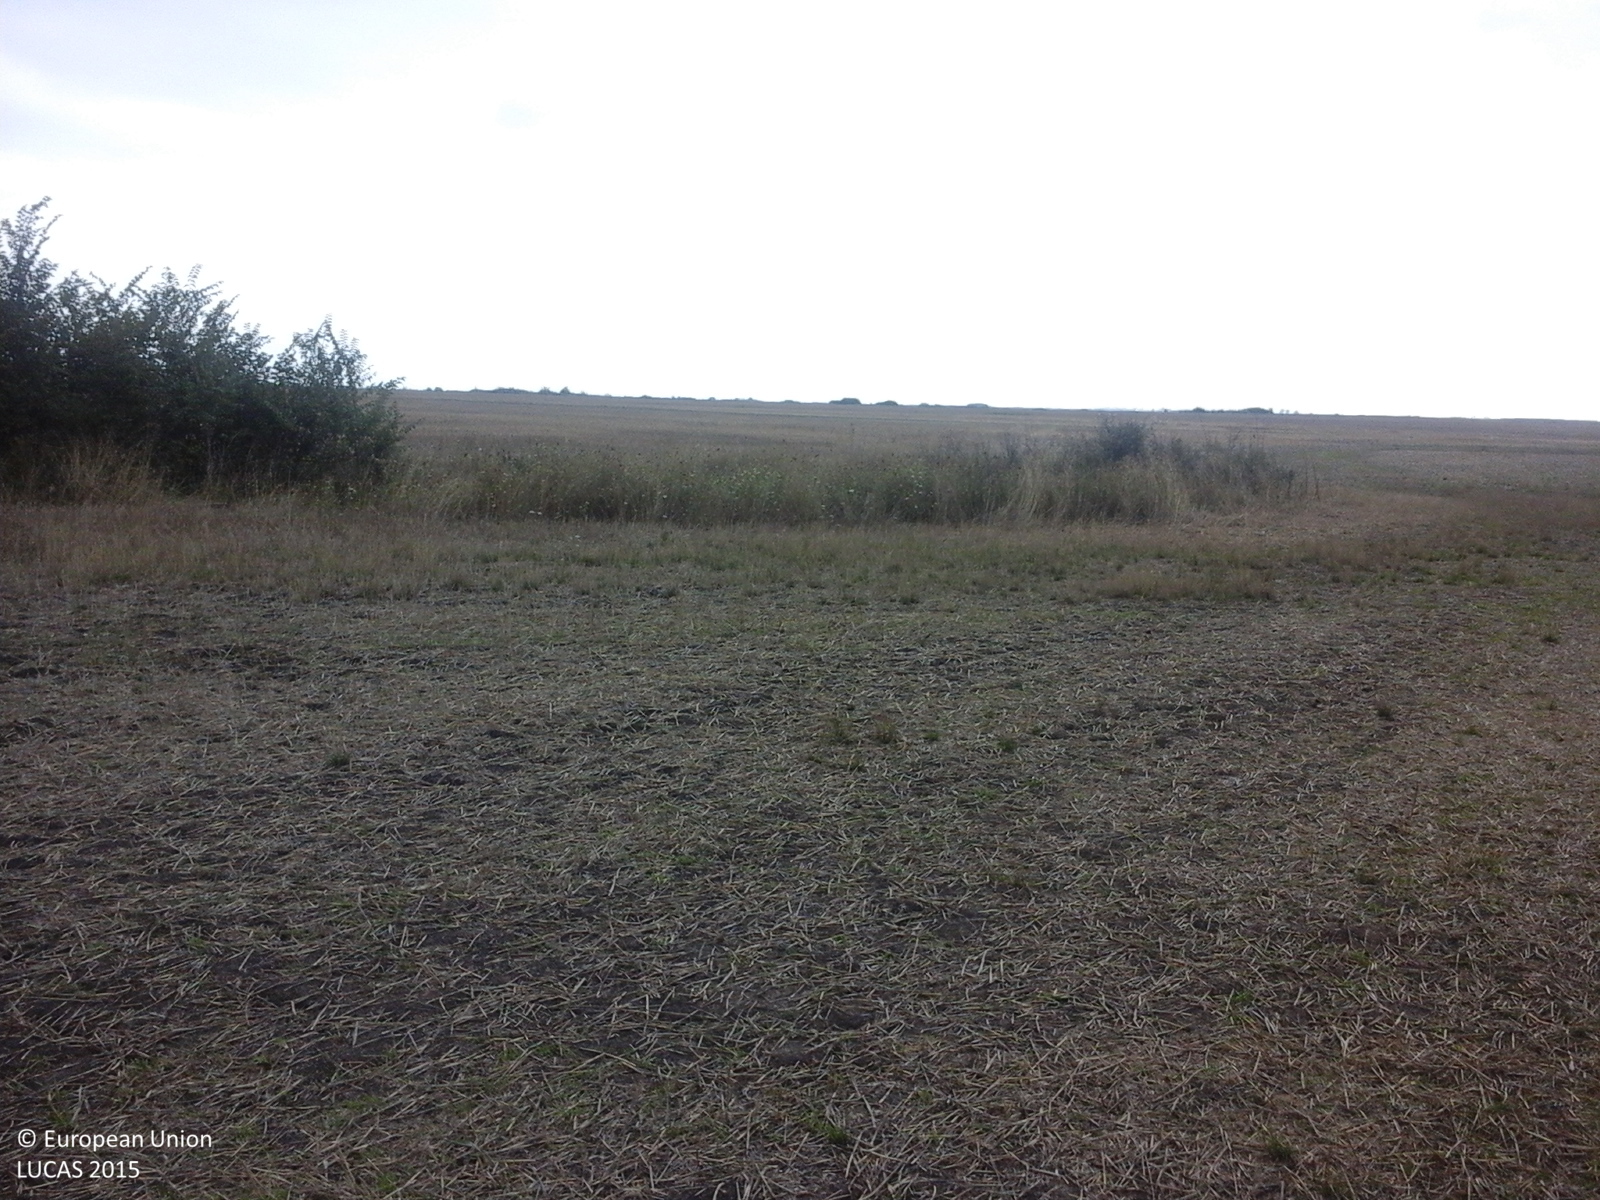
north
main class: Cropland
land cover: Common wheat
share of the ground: 25 - 50 %
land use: Agriculture (excluding fallow land and kitchen gardens)
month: August
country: RO
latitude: 45.4076
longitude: 21.1047
